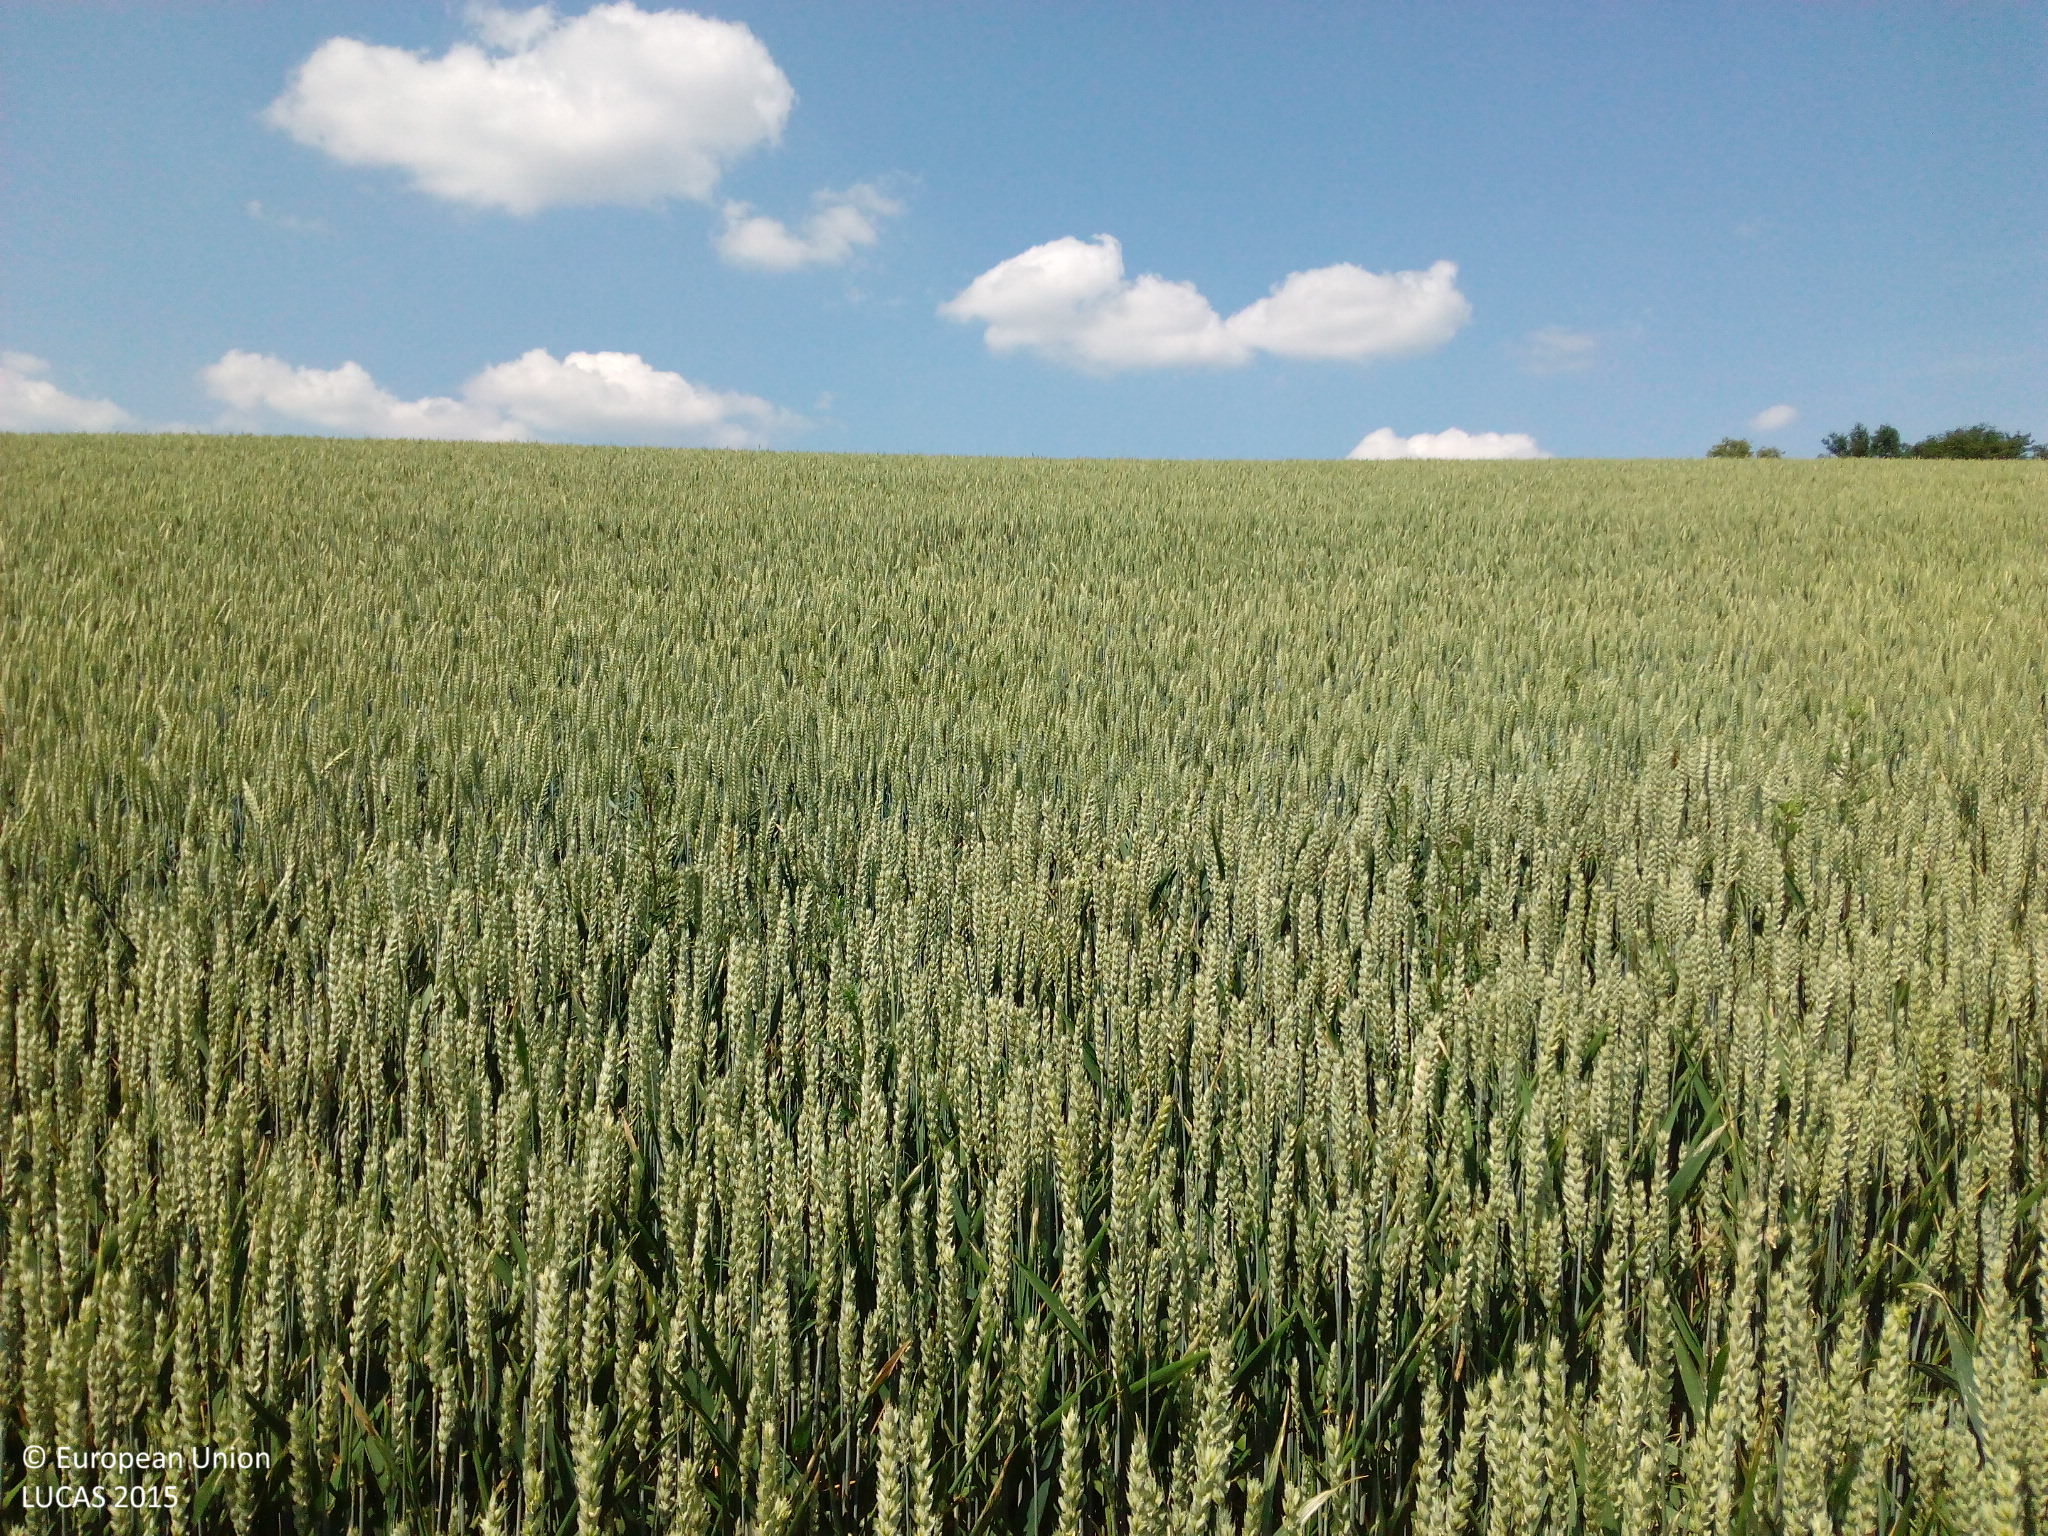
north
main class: Cropland
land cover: Common wheat
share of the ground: > 75 %
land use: Agriculture (excluding fallow land and kitchen gardens)
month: June
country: DE
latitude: 49.3022
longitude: 9.5738
